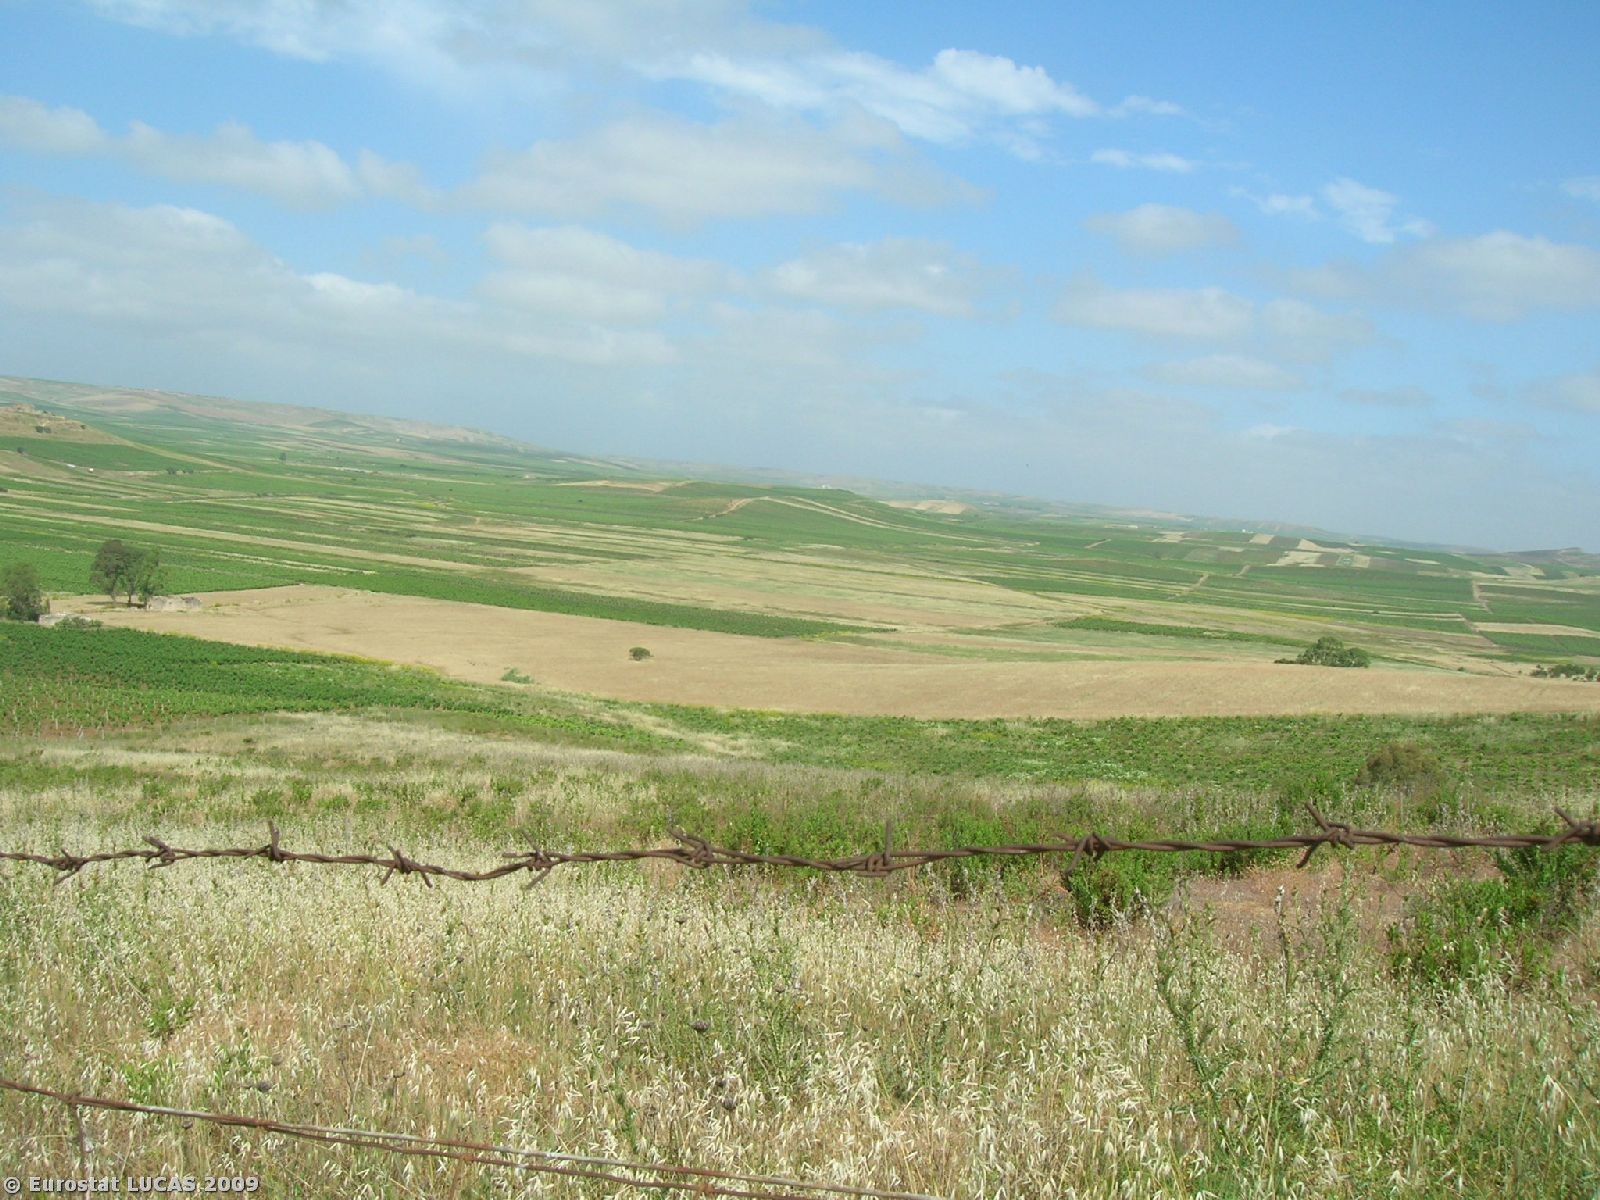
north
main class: Grassland
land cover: Spontaneously vegetated surfaces
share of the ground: > 75 %
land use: Fallow land
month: May
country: IT
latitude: 37.8202
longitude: 12.6274
